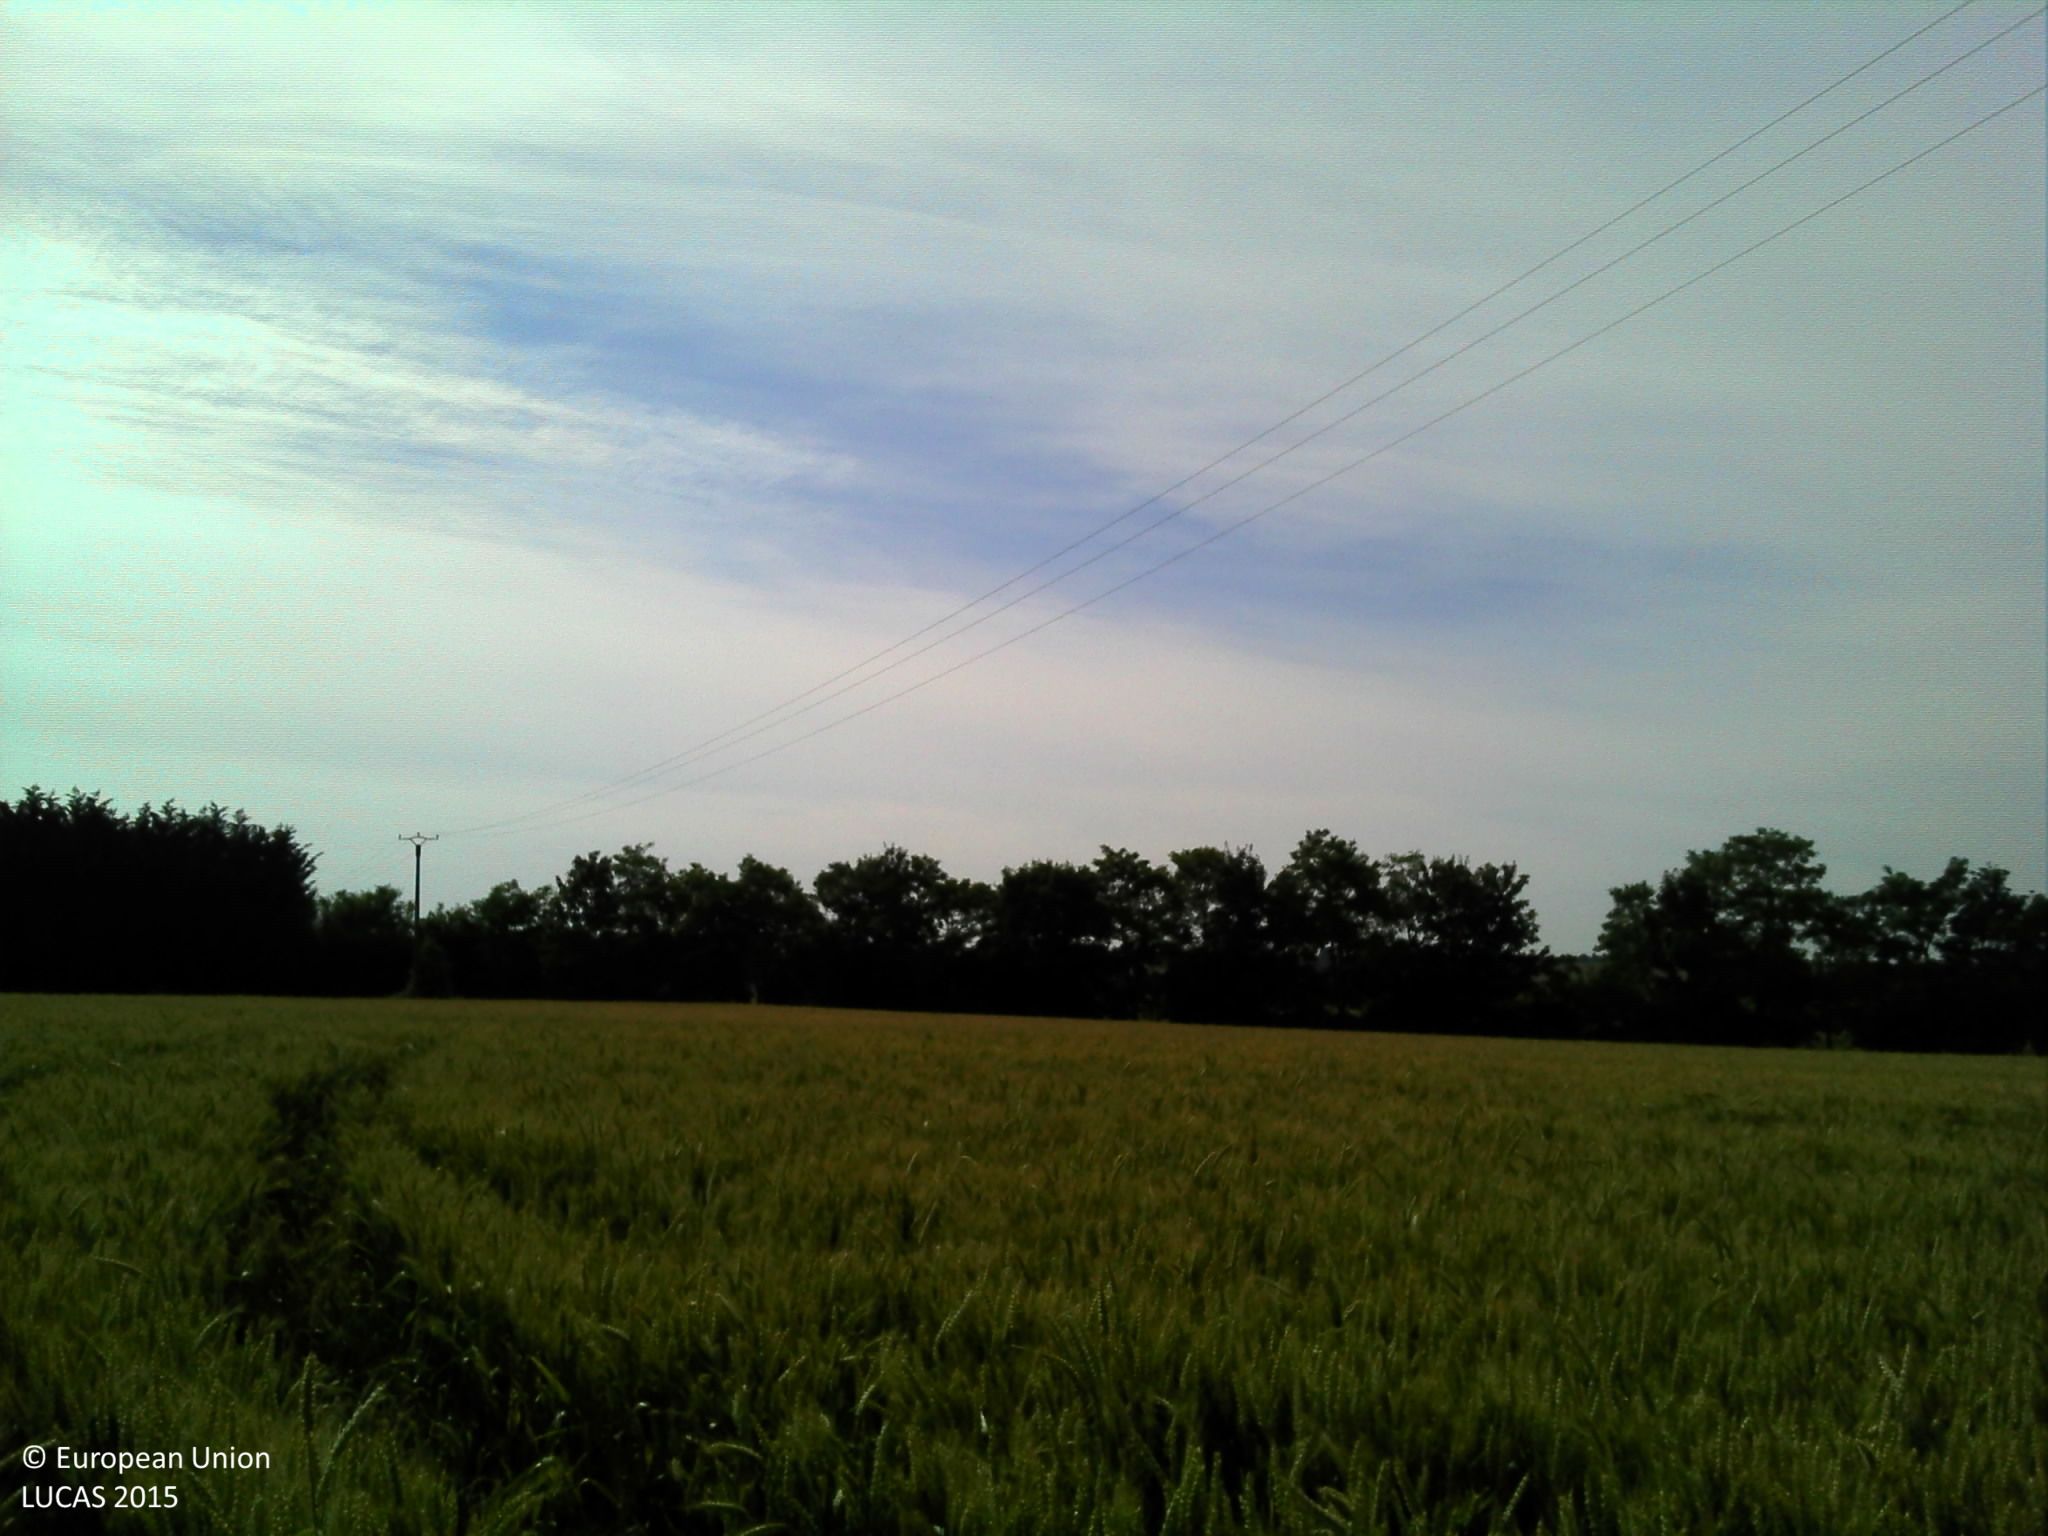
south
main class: Cropland
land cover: Common wheat
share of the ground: > 75 %
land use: Agriculture (excluding fallow land and kitchen gardens)
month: June
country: FR
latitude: 48.3243
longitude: 0.1402
